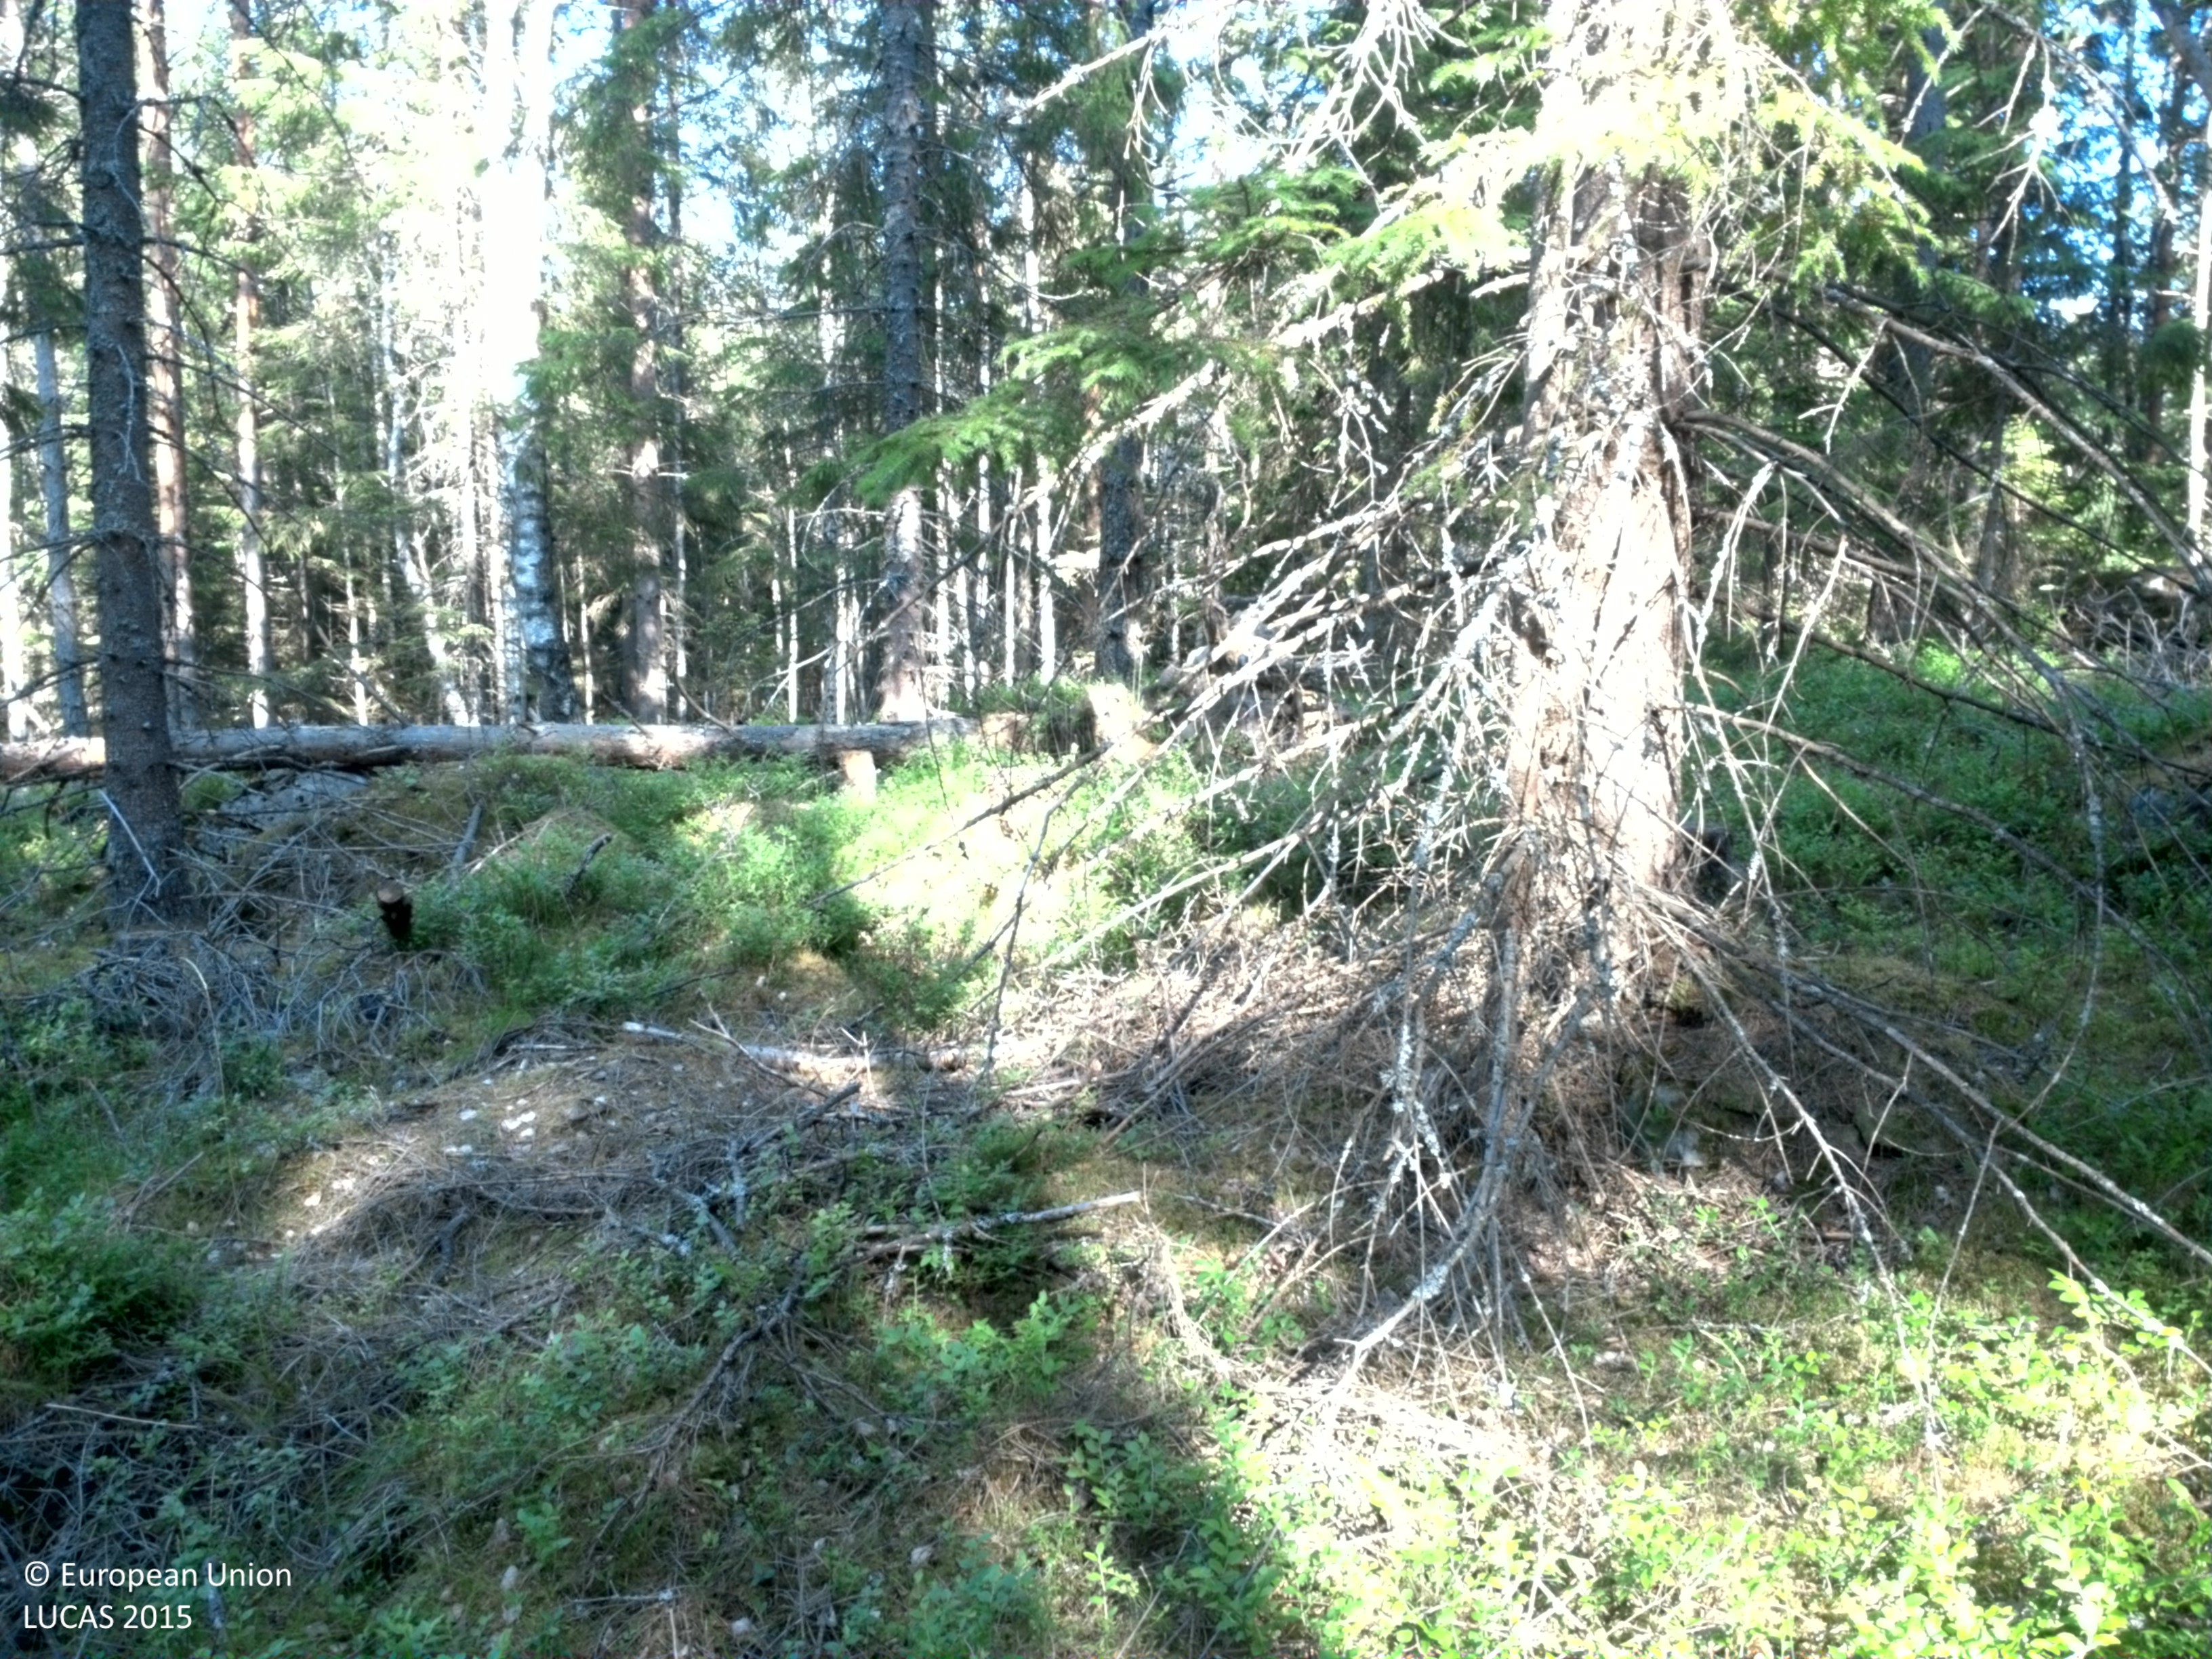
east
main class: Woodland
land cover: Pine dominated mixed woodland
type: boreal forest
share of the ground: 50 - 75 %
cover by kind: coniferous forest trees 40 %, shrubs 30 %, broadleaved forest trees 20 %, herbaceous plants 5 %, consolidated bare surface 5 %
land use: Forestry
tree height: > 5 m
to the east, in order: Pine dominated mixed woodland; Spruce dominated mixed woodland; Other mixed woodland; Spruce dominated mixed woodland; Ditches and canals; Other coniferous woodland; Pine dominated coniferous woodland; Spruce dominated mixed woodland
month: July
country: SE
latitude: 59.1695
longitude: 14.5576
